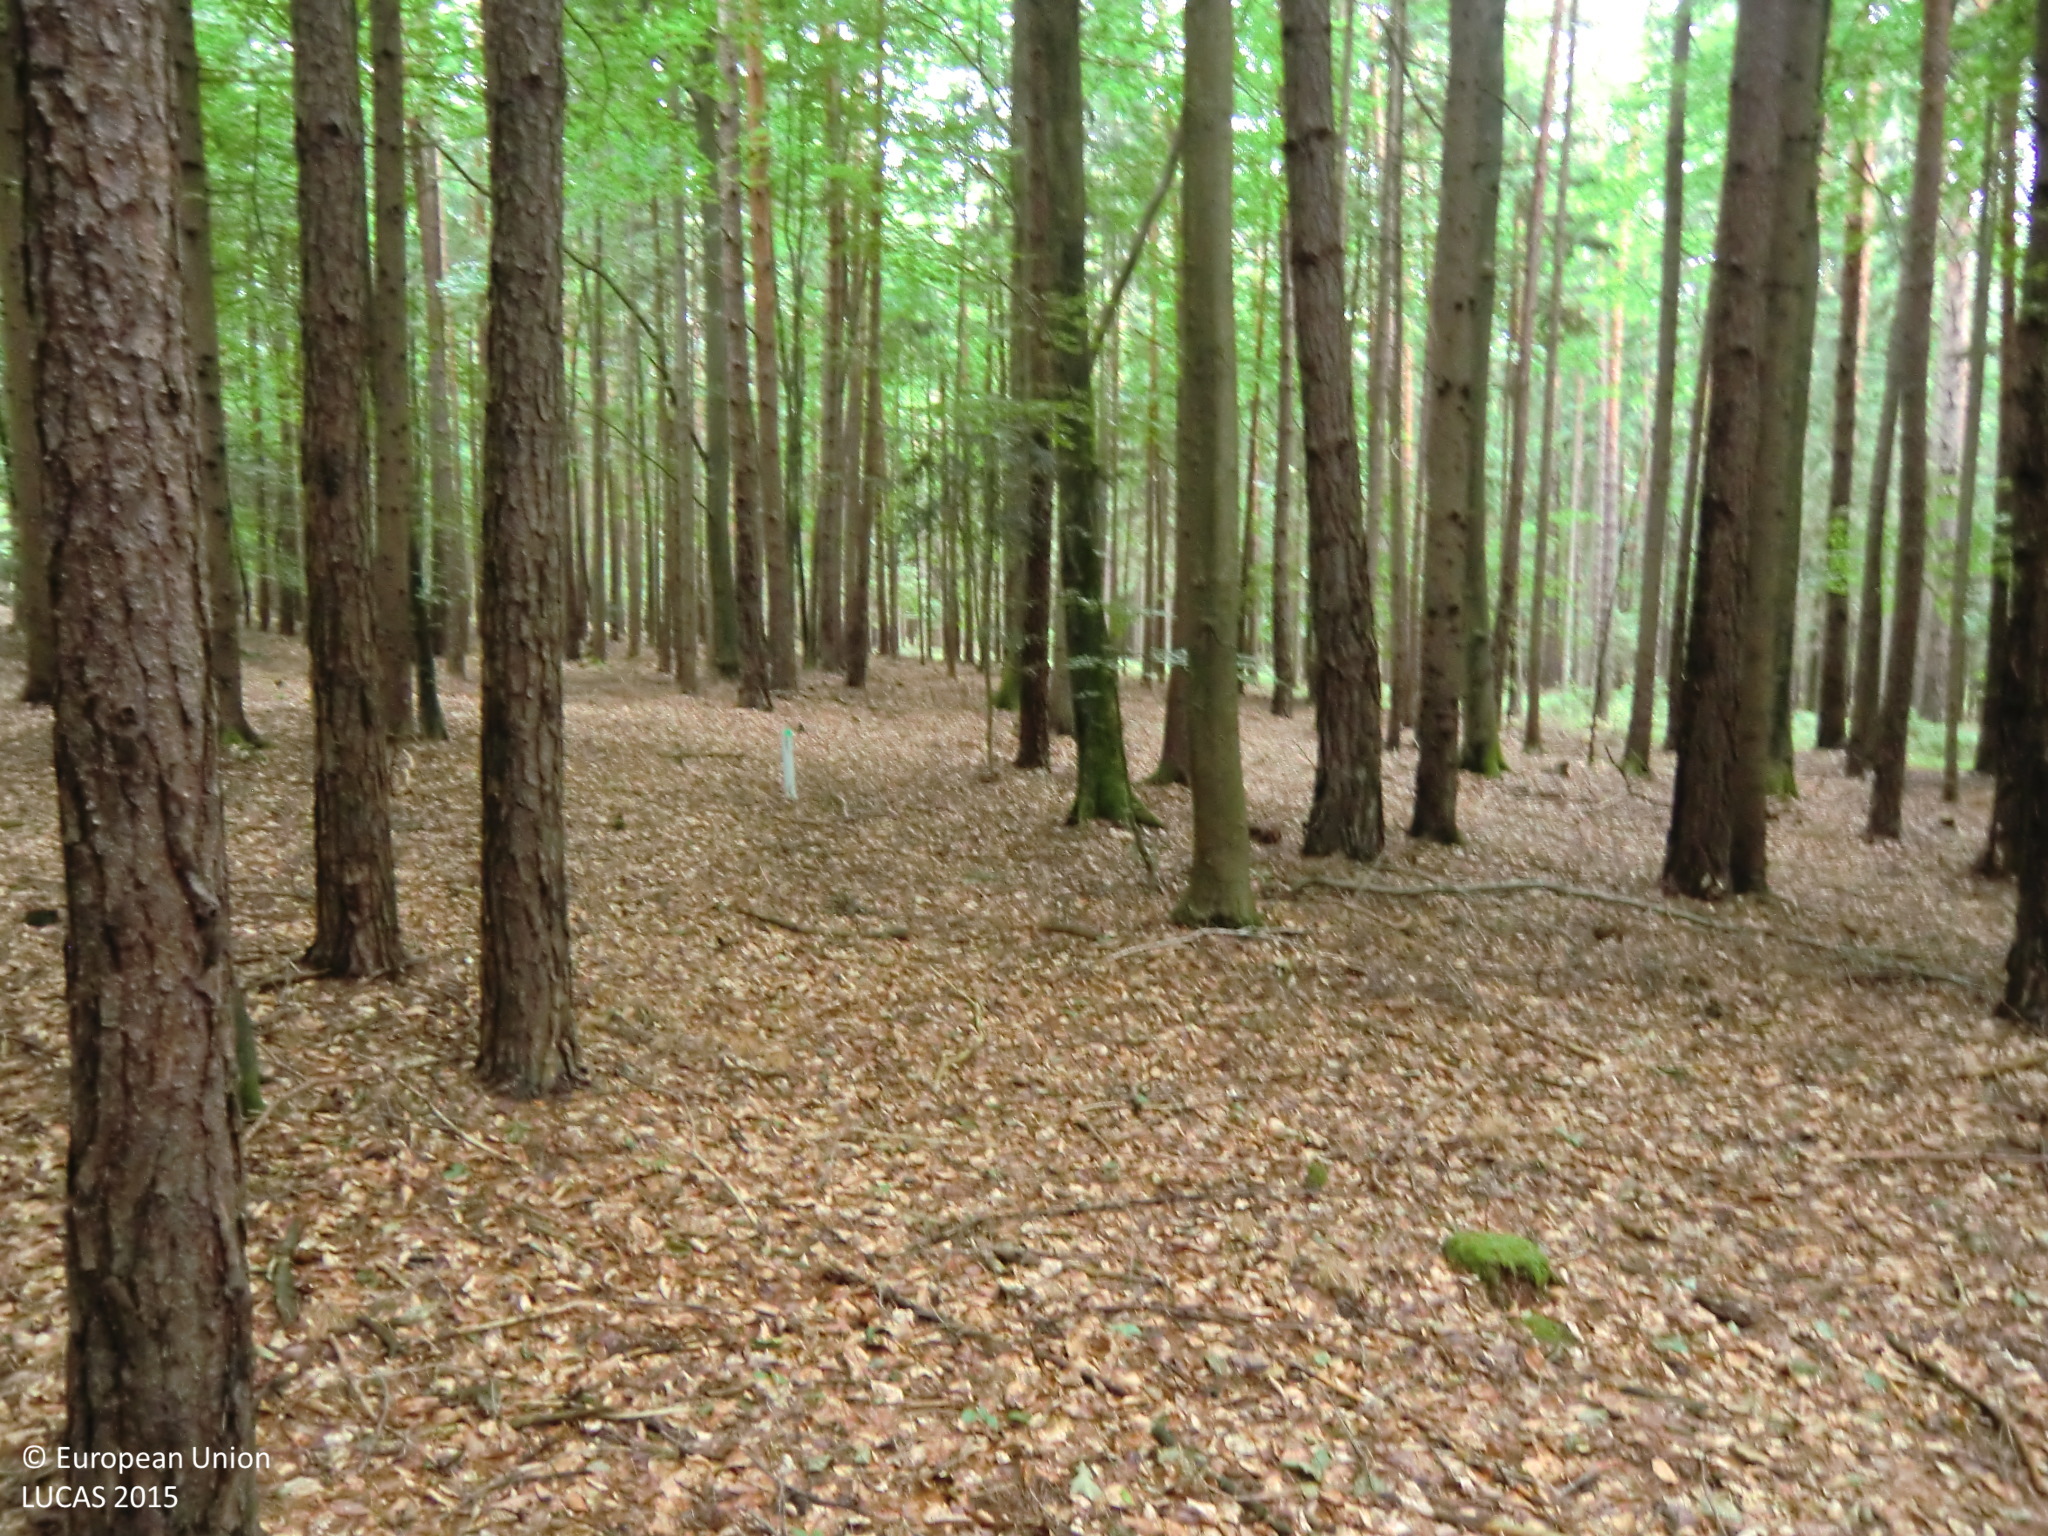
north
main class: Woodland
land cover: Other mixed woodland
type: hemiboreal forest and nemoral coniferous forest and mixed broadleaved-coniferous forest
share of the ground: > 75 %
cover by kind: coniferous forest trees 60 %, broadleaved forest trees 30 %, unconsolidated bare surface 10 %
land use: Forestry
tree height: > 5 m
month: June
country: AT
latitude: 47.2817
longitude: 16.0436
